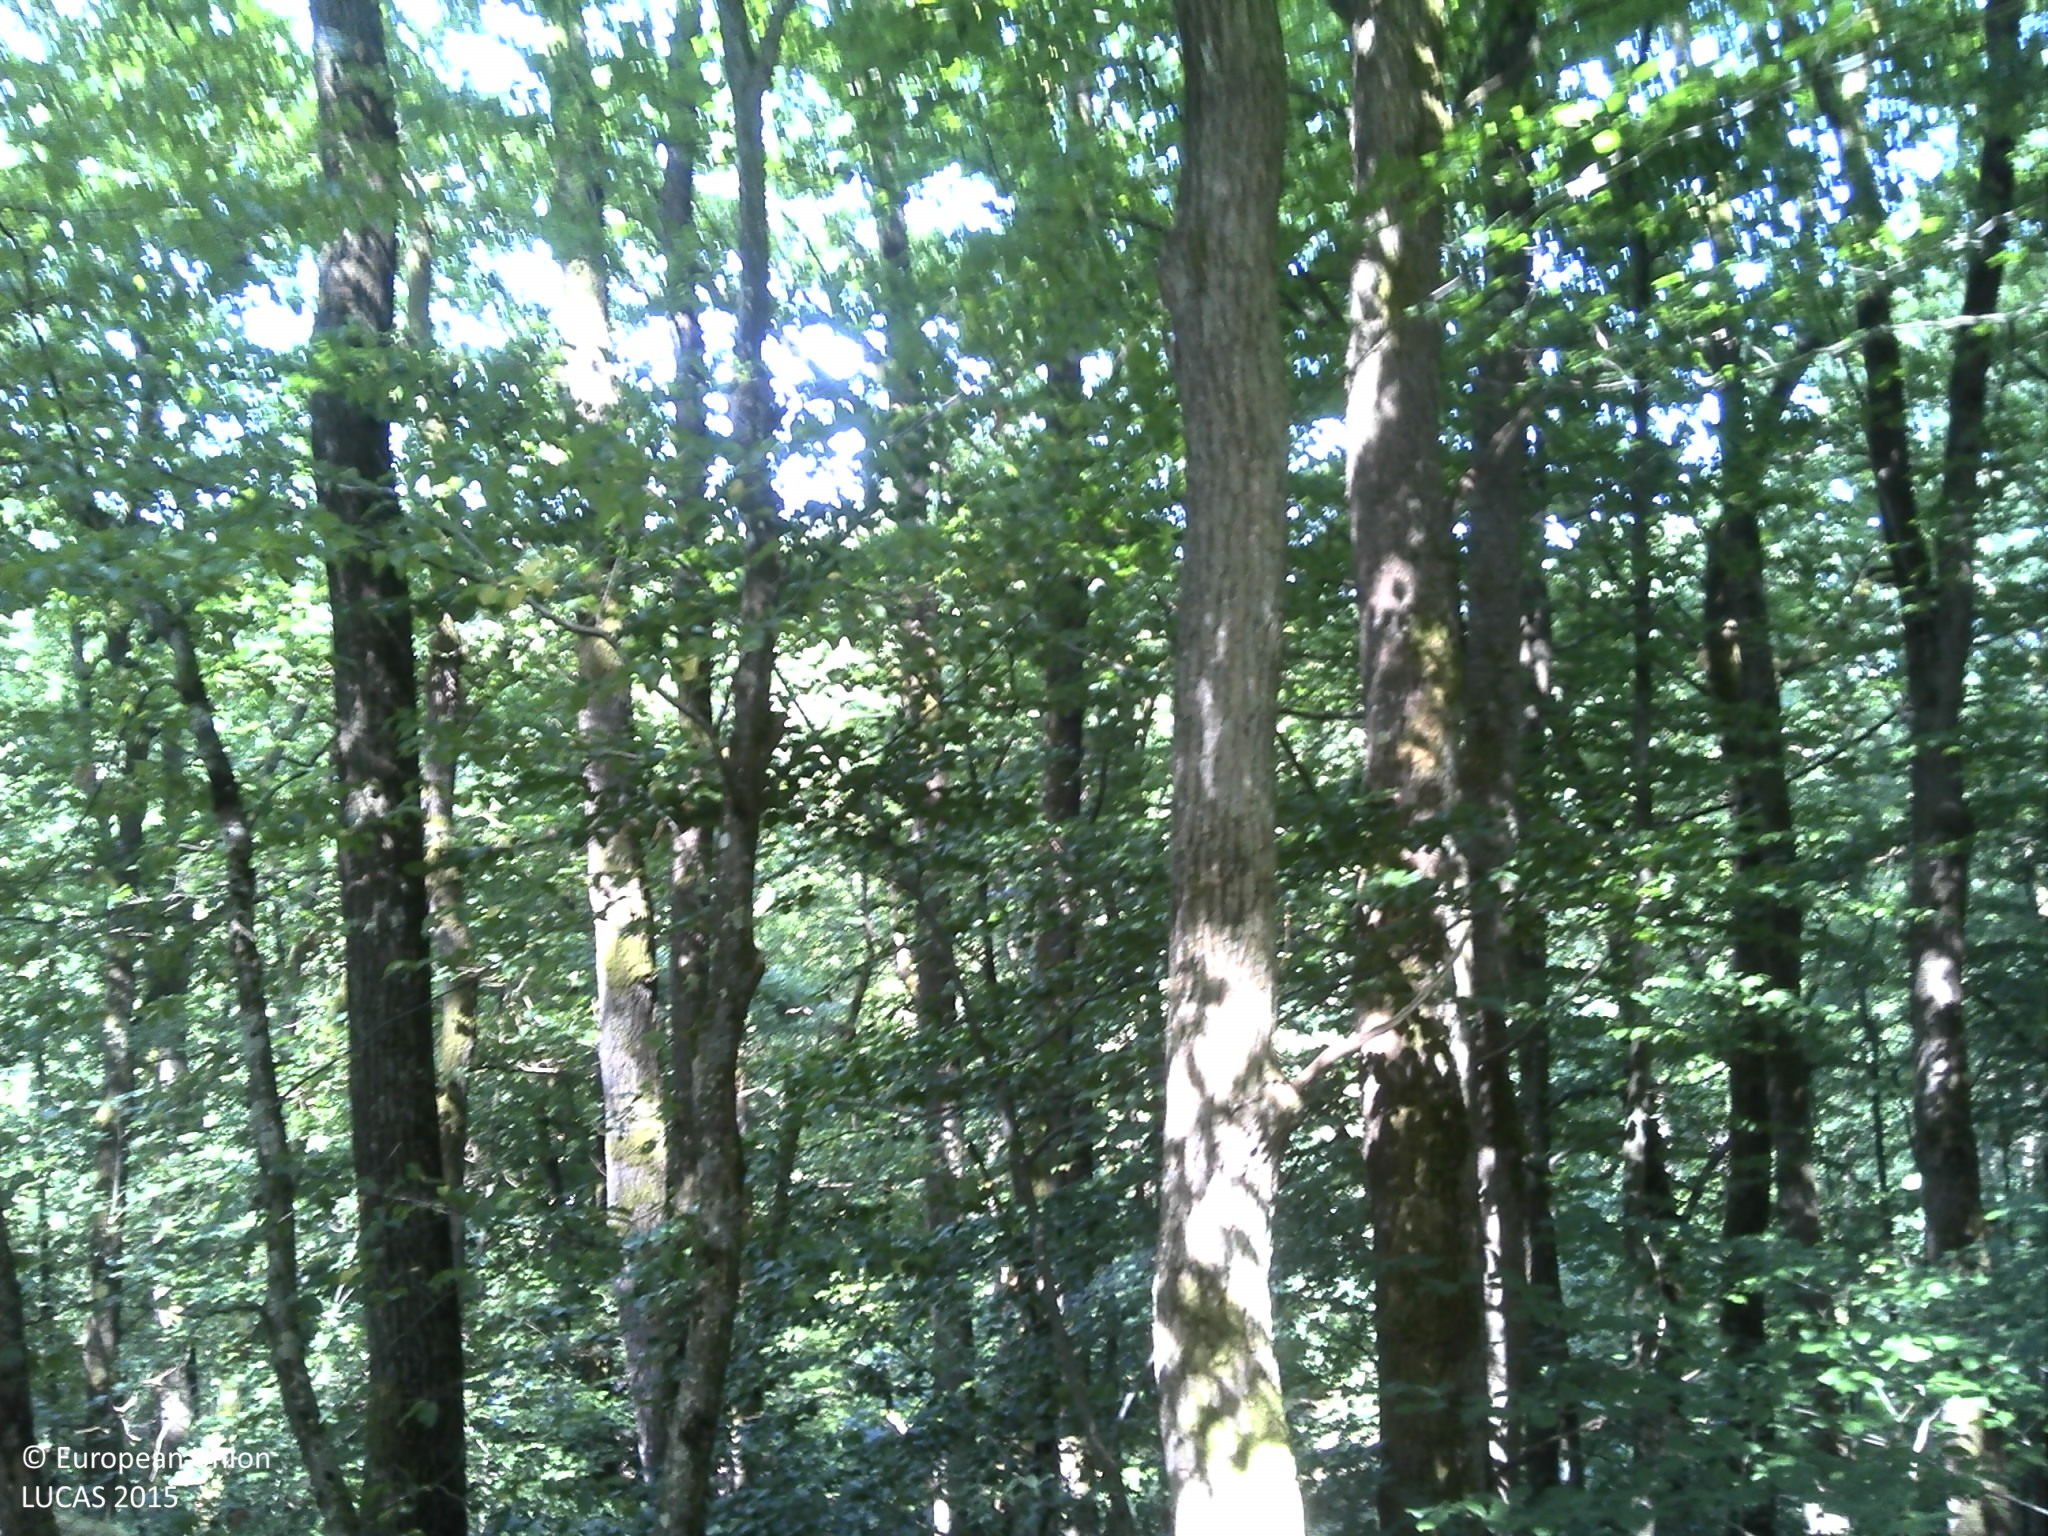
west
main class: Woodland
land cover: Broadleaved woodland
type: acidophilous oak and oak-birch forest
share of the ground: > 75 %
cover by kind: broadleaved forest trees 90 %, lichens and mosses 10 %
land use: Forestry
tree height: > 5 m
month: July
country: FR
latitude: 48.9699
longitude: 7.5280
